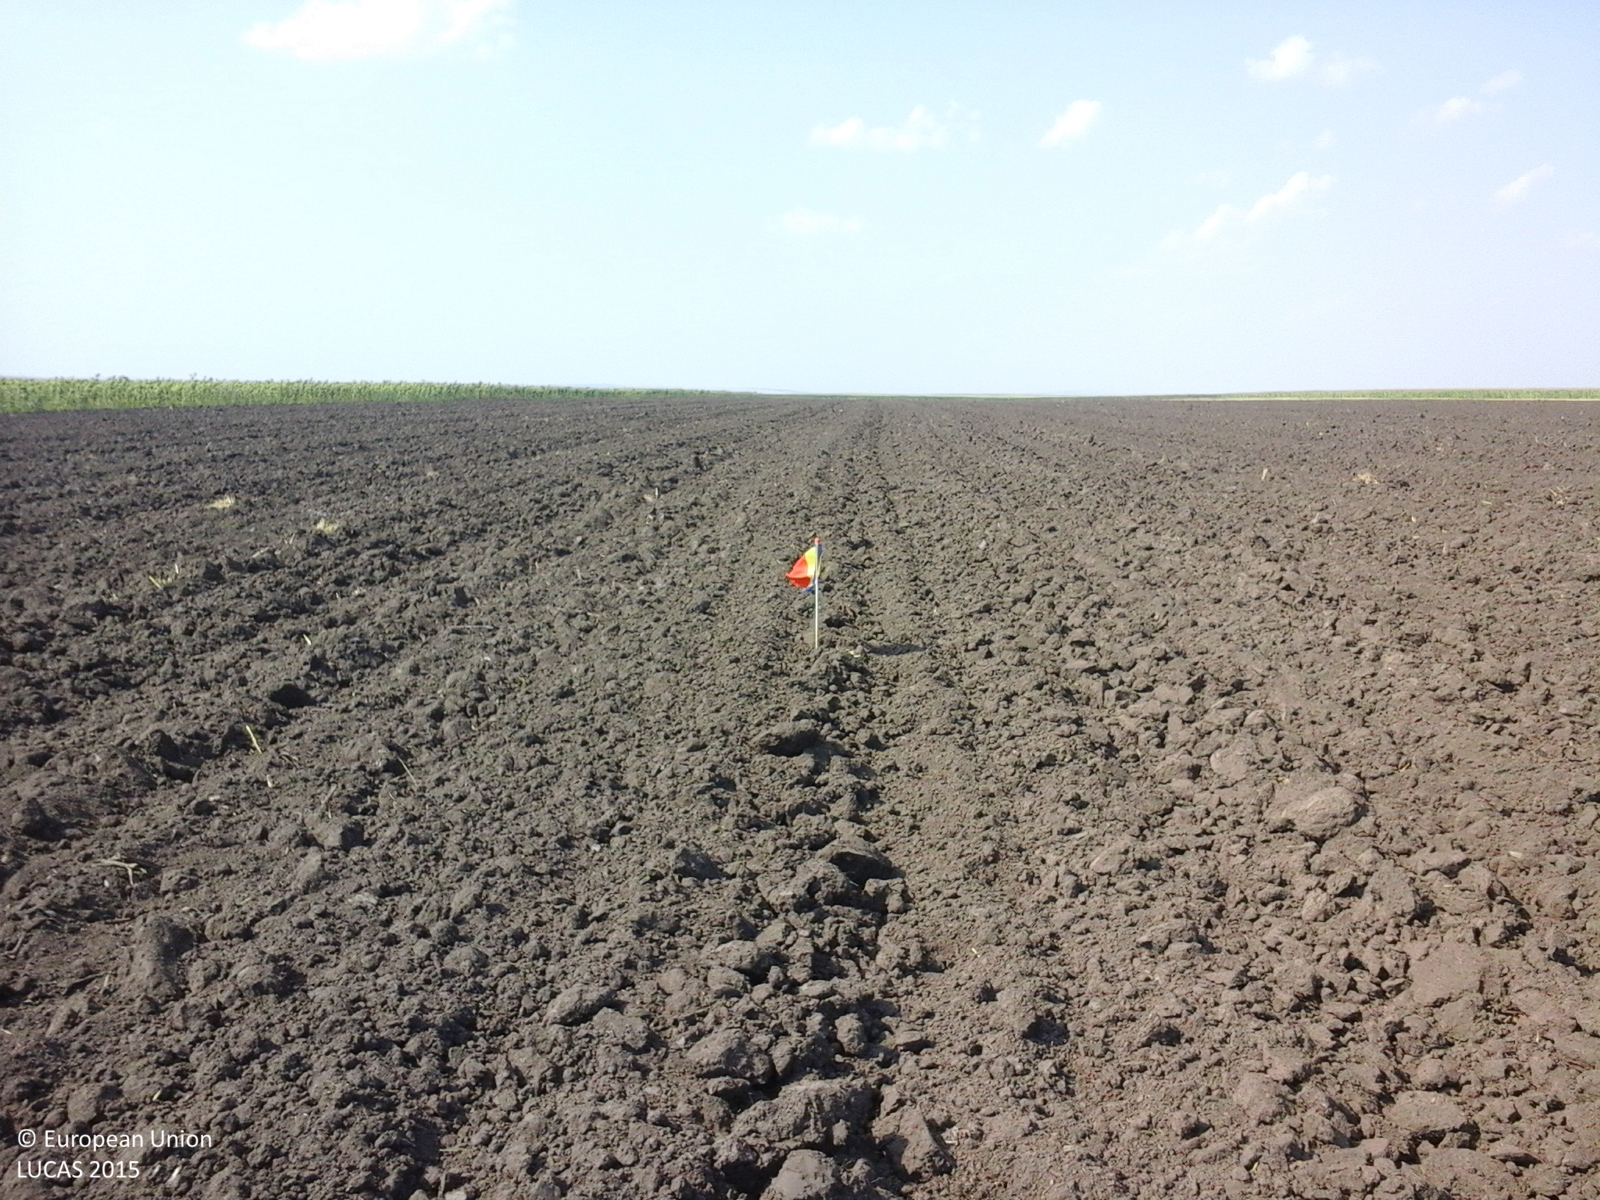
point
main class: Cropland
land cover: Common wheat
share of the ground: < 10 %
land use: Agriculture (excluding fallow land and kitchen gardens)
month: July
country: RO
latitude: 45.9947
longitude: 27.5246
